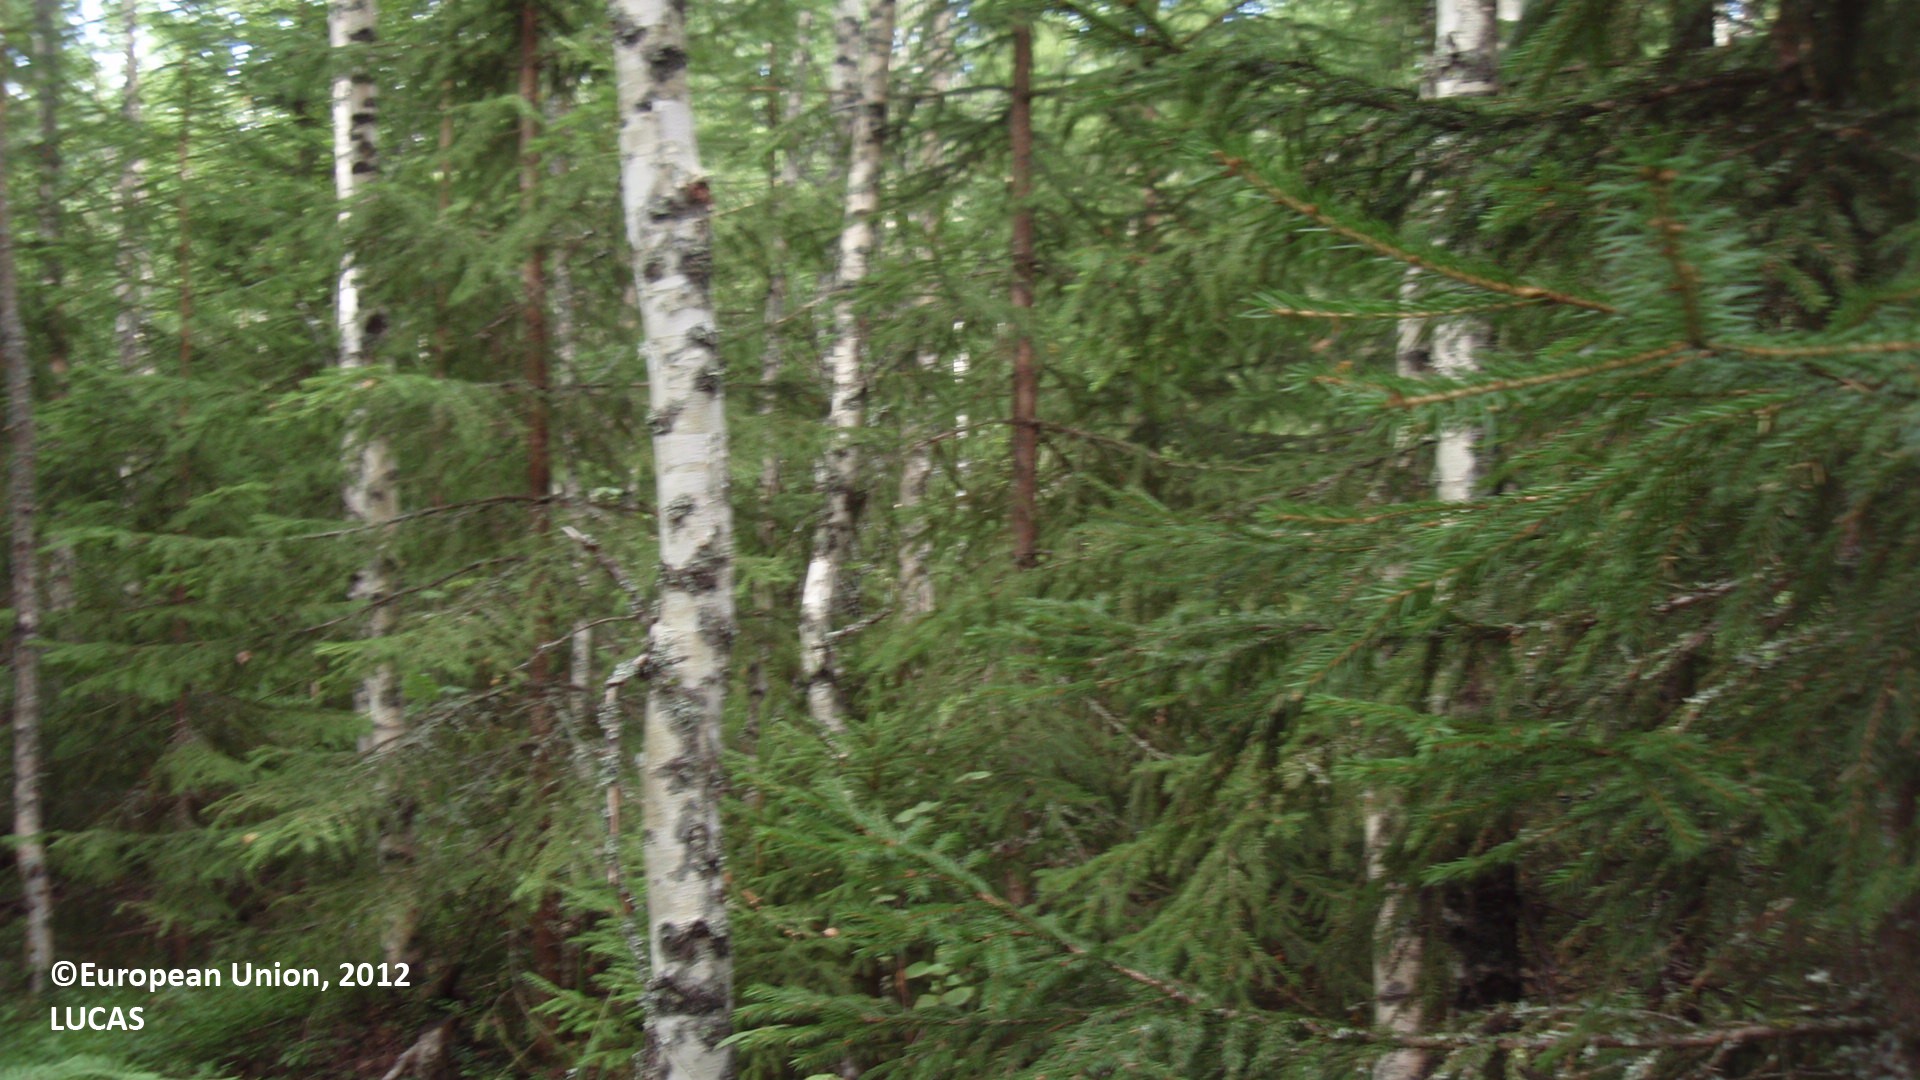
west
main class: Woodland
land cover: Spruce dominated mixed woodland
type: boreal forest
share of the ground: 50 - 75 %
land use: Forestry
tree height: > 5 m
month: August
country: FI
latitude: 60.9290
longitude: 27.3167
